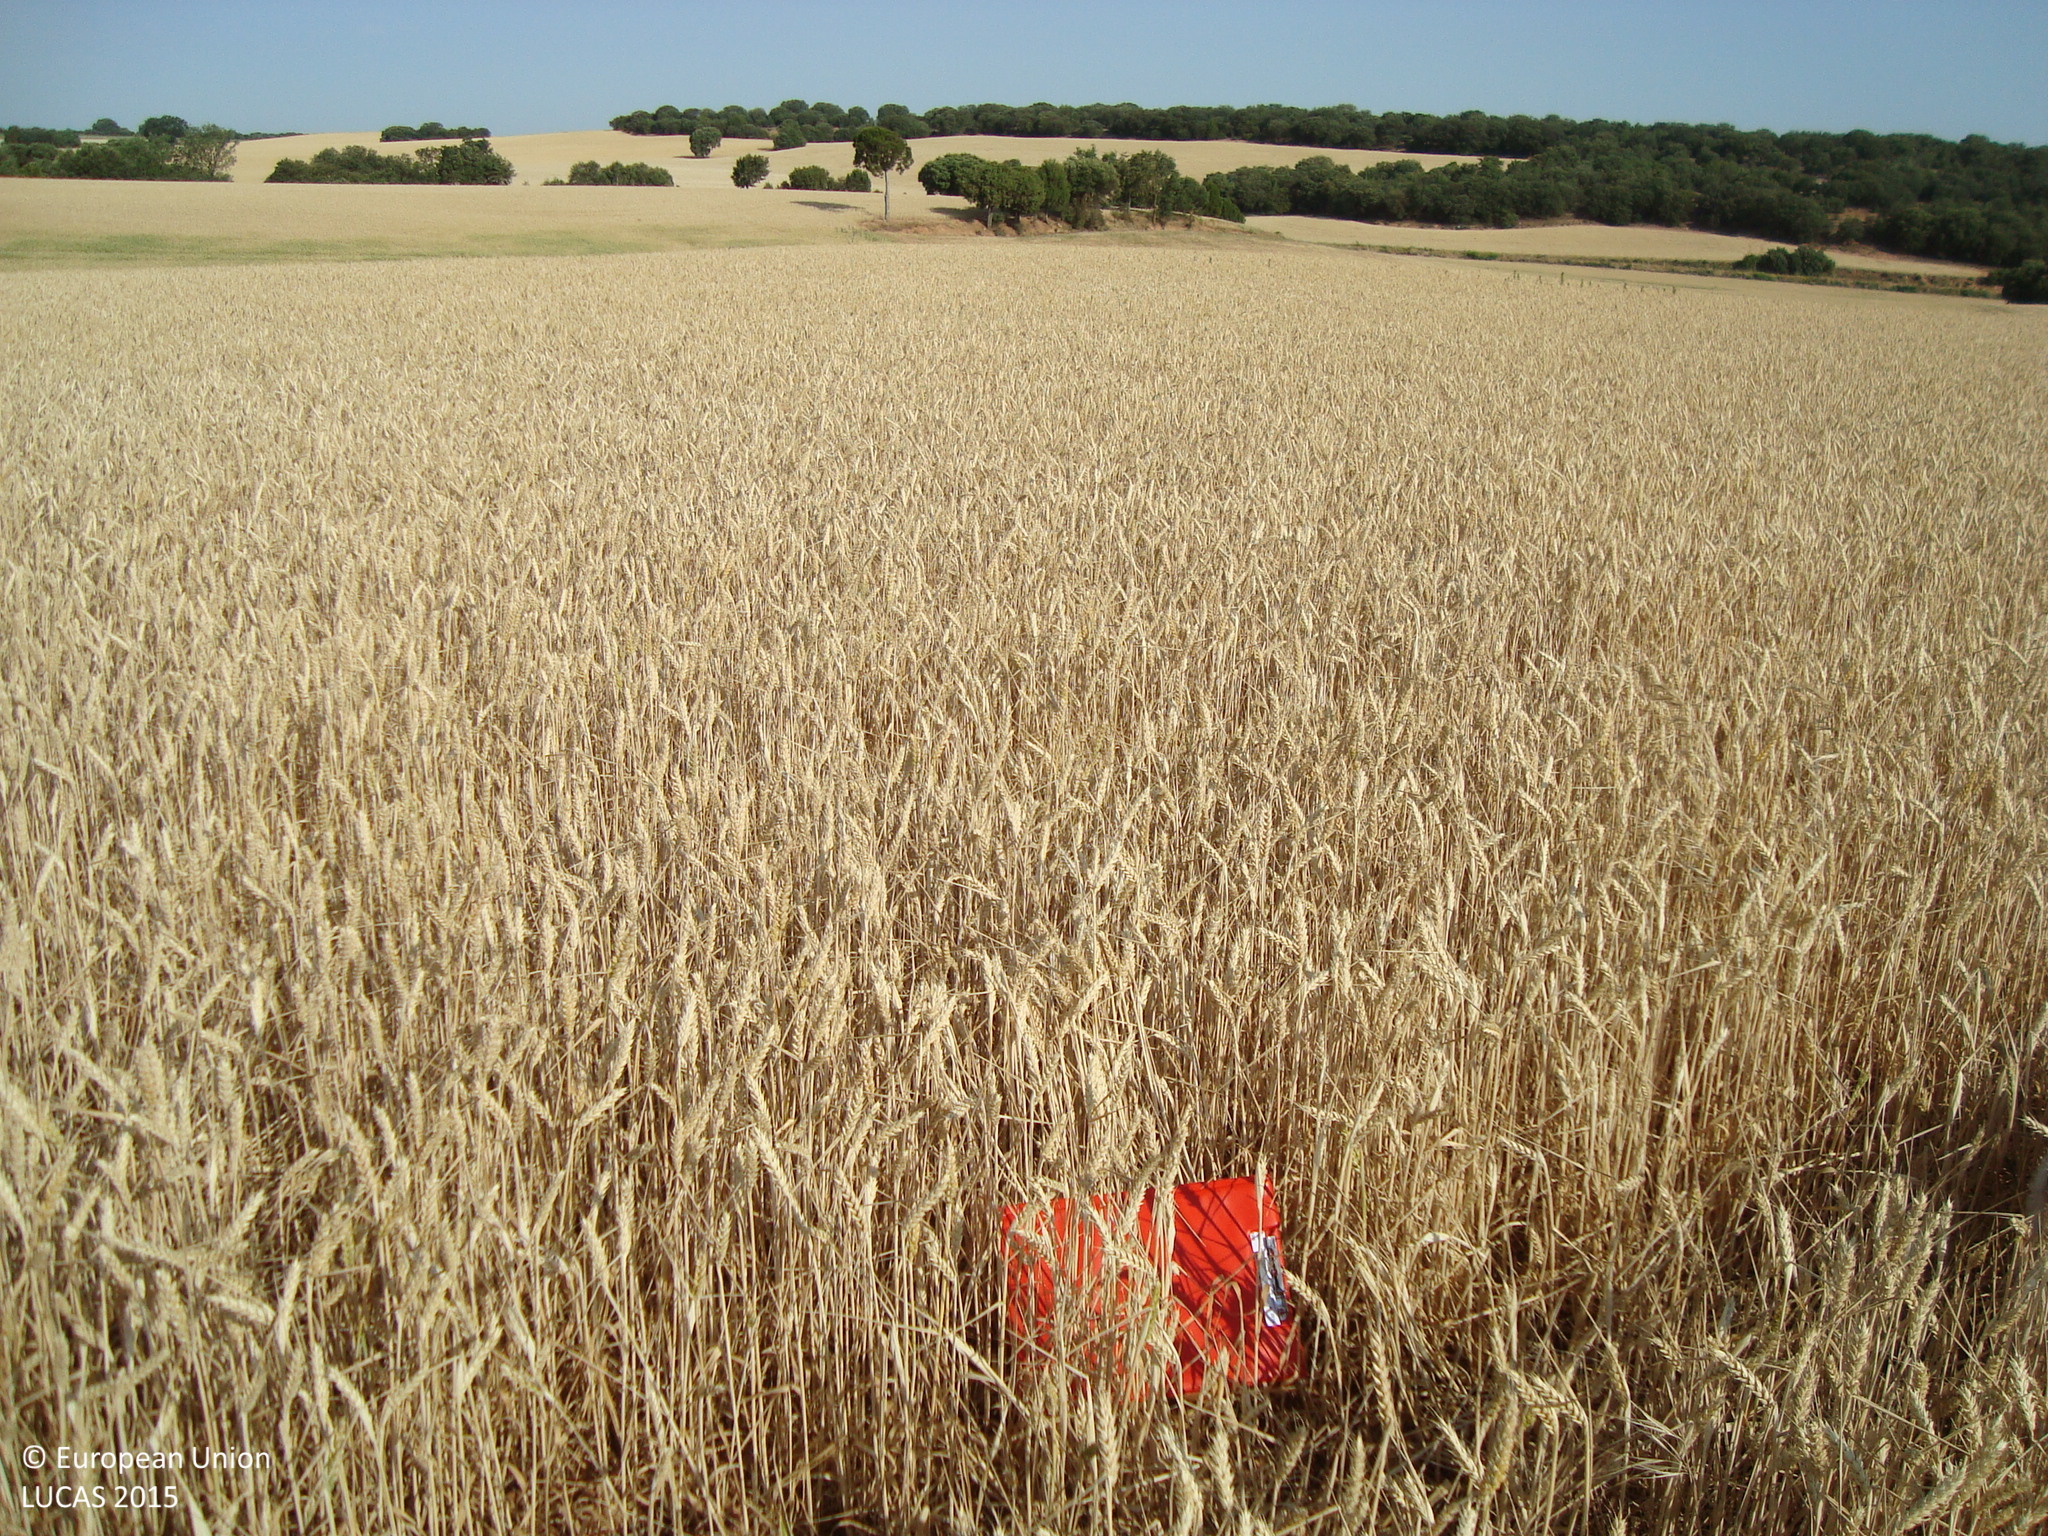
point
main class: Cropland
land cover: Common wheat
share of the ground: > 75 %
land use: Agriculture (excluding fallow land and kitchen gardens)
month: June
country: ES
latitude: 41.9815
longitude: -3.7805
